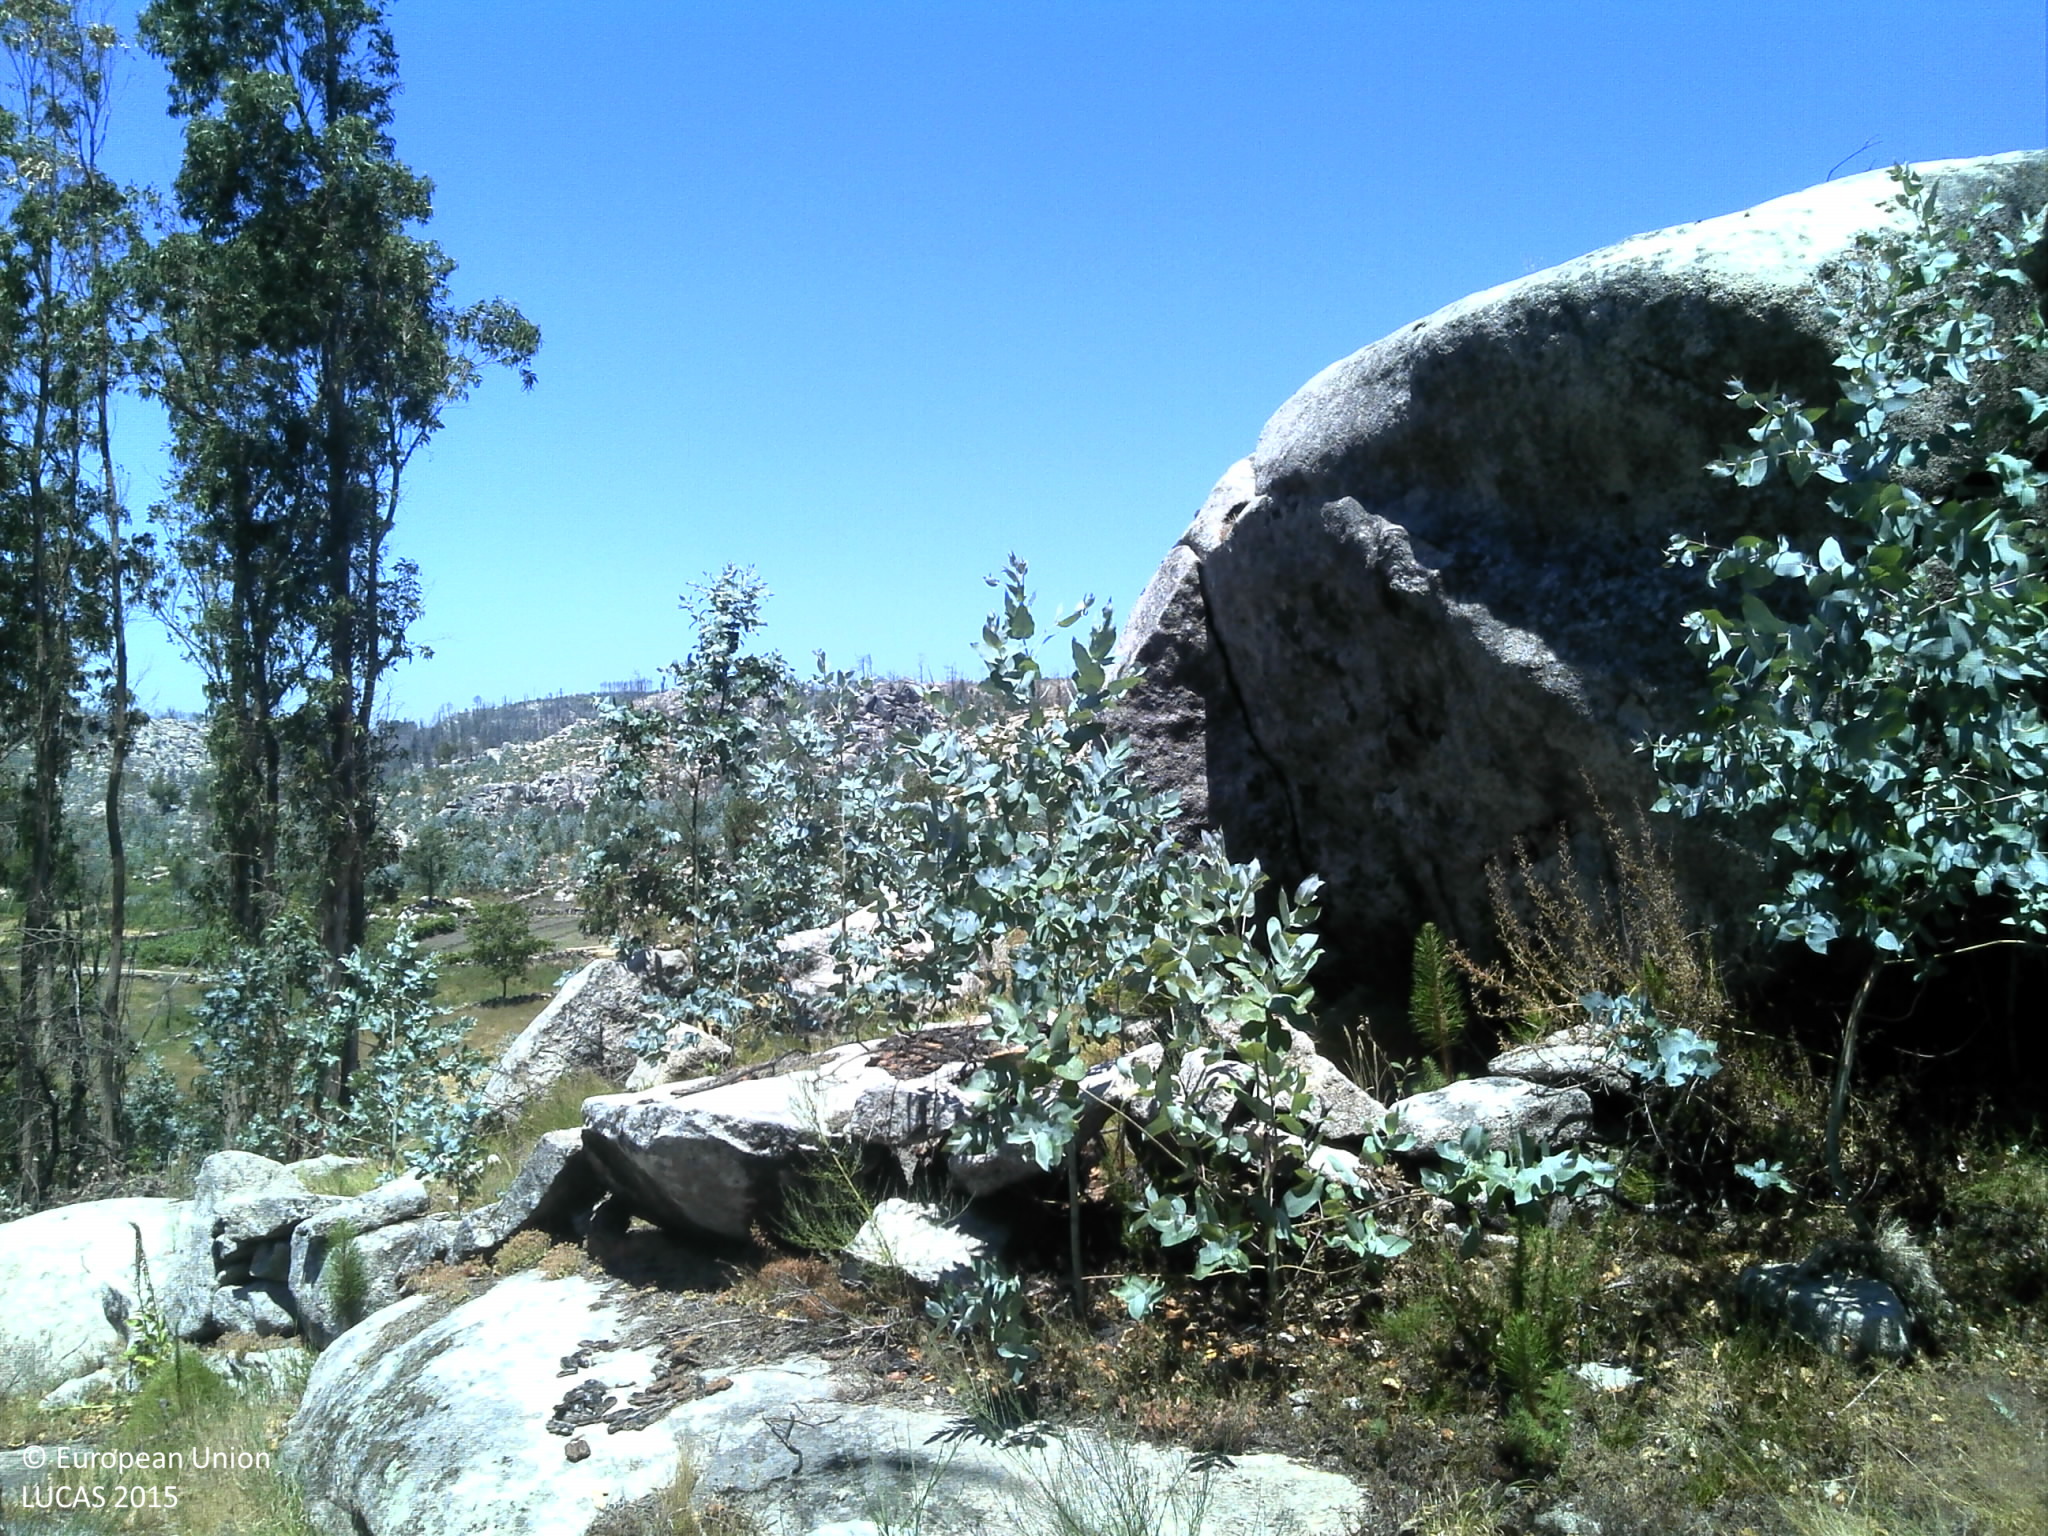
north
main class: Woodland
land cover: Broadleaved woodland
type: exotic forest
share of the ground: 50 - 75 %
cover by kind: broadleaved forest trees 50 %, consolidated bare surface 25 %, shrubs 10 %, herbaceous plants 10 %, unconsolidated bare surface 5 %
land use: Forestry
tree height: < 5 m
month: June
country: PT
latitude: 40.5569
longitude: -8.2358
